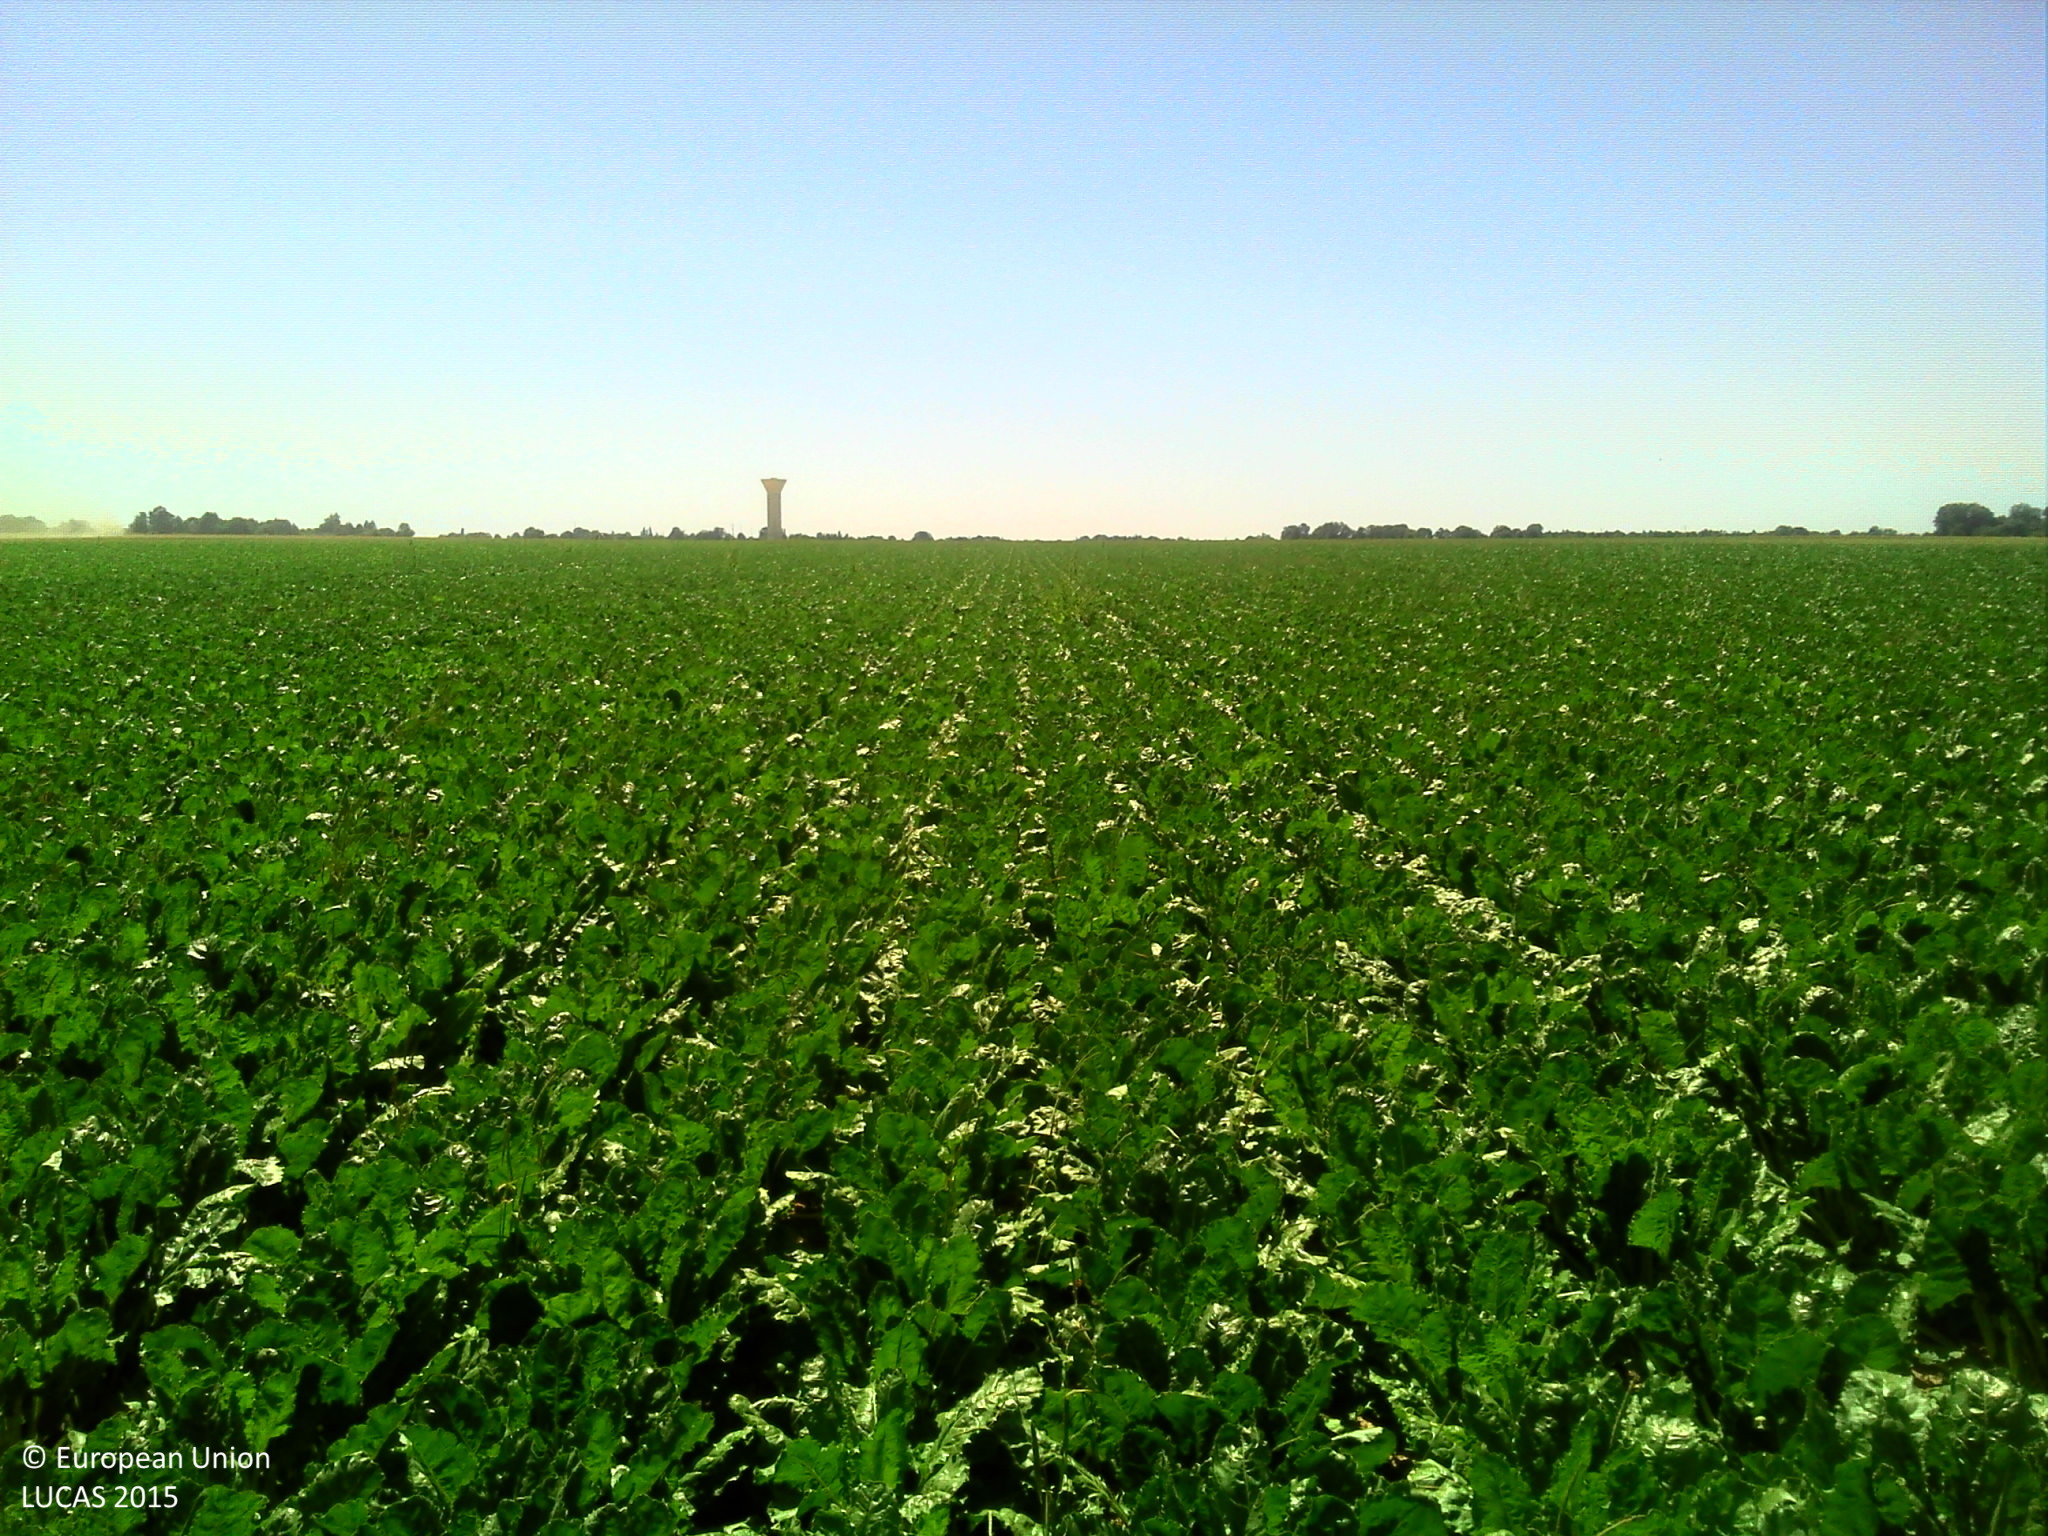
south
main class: Cropland
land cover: Sugar beet
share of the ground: > 75 %
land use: Agriculture (excluding fallow land and kitchen gardens)
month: July
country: FR
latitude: 49.0568
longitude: 0.4353
